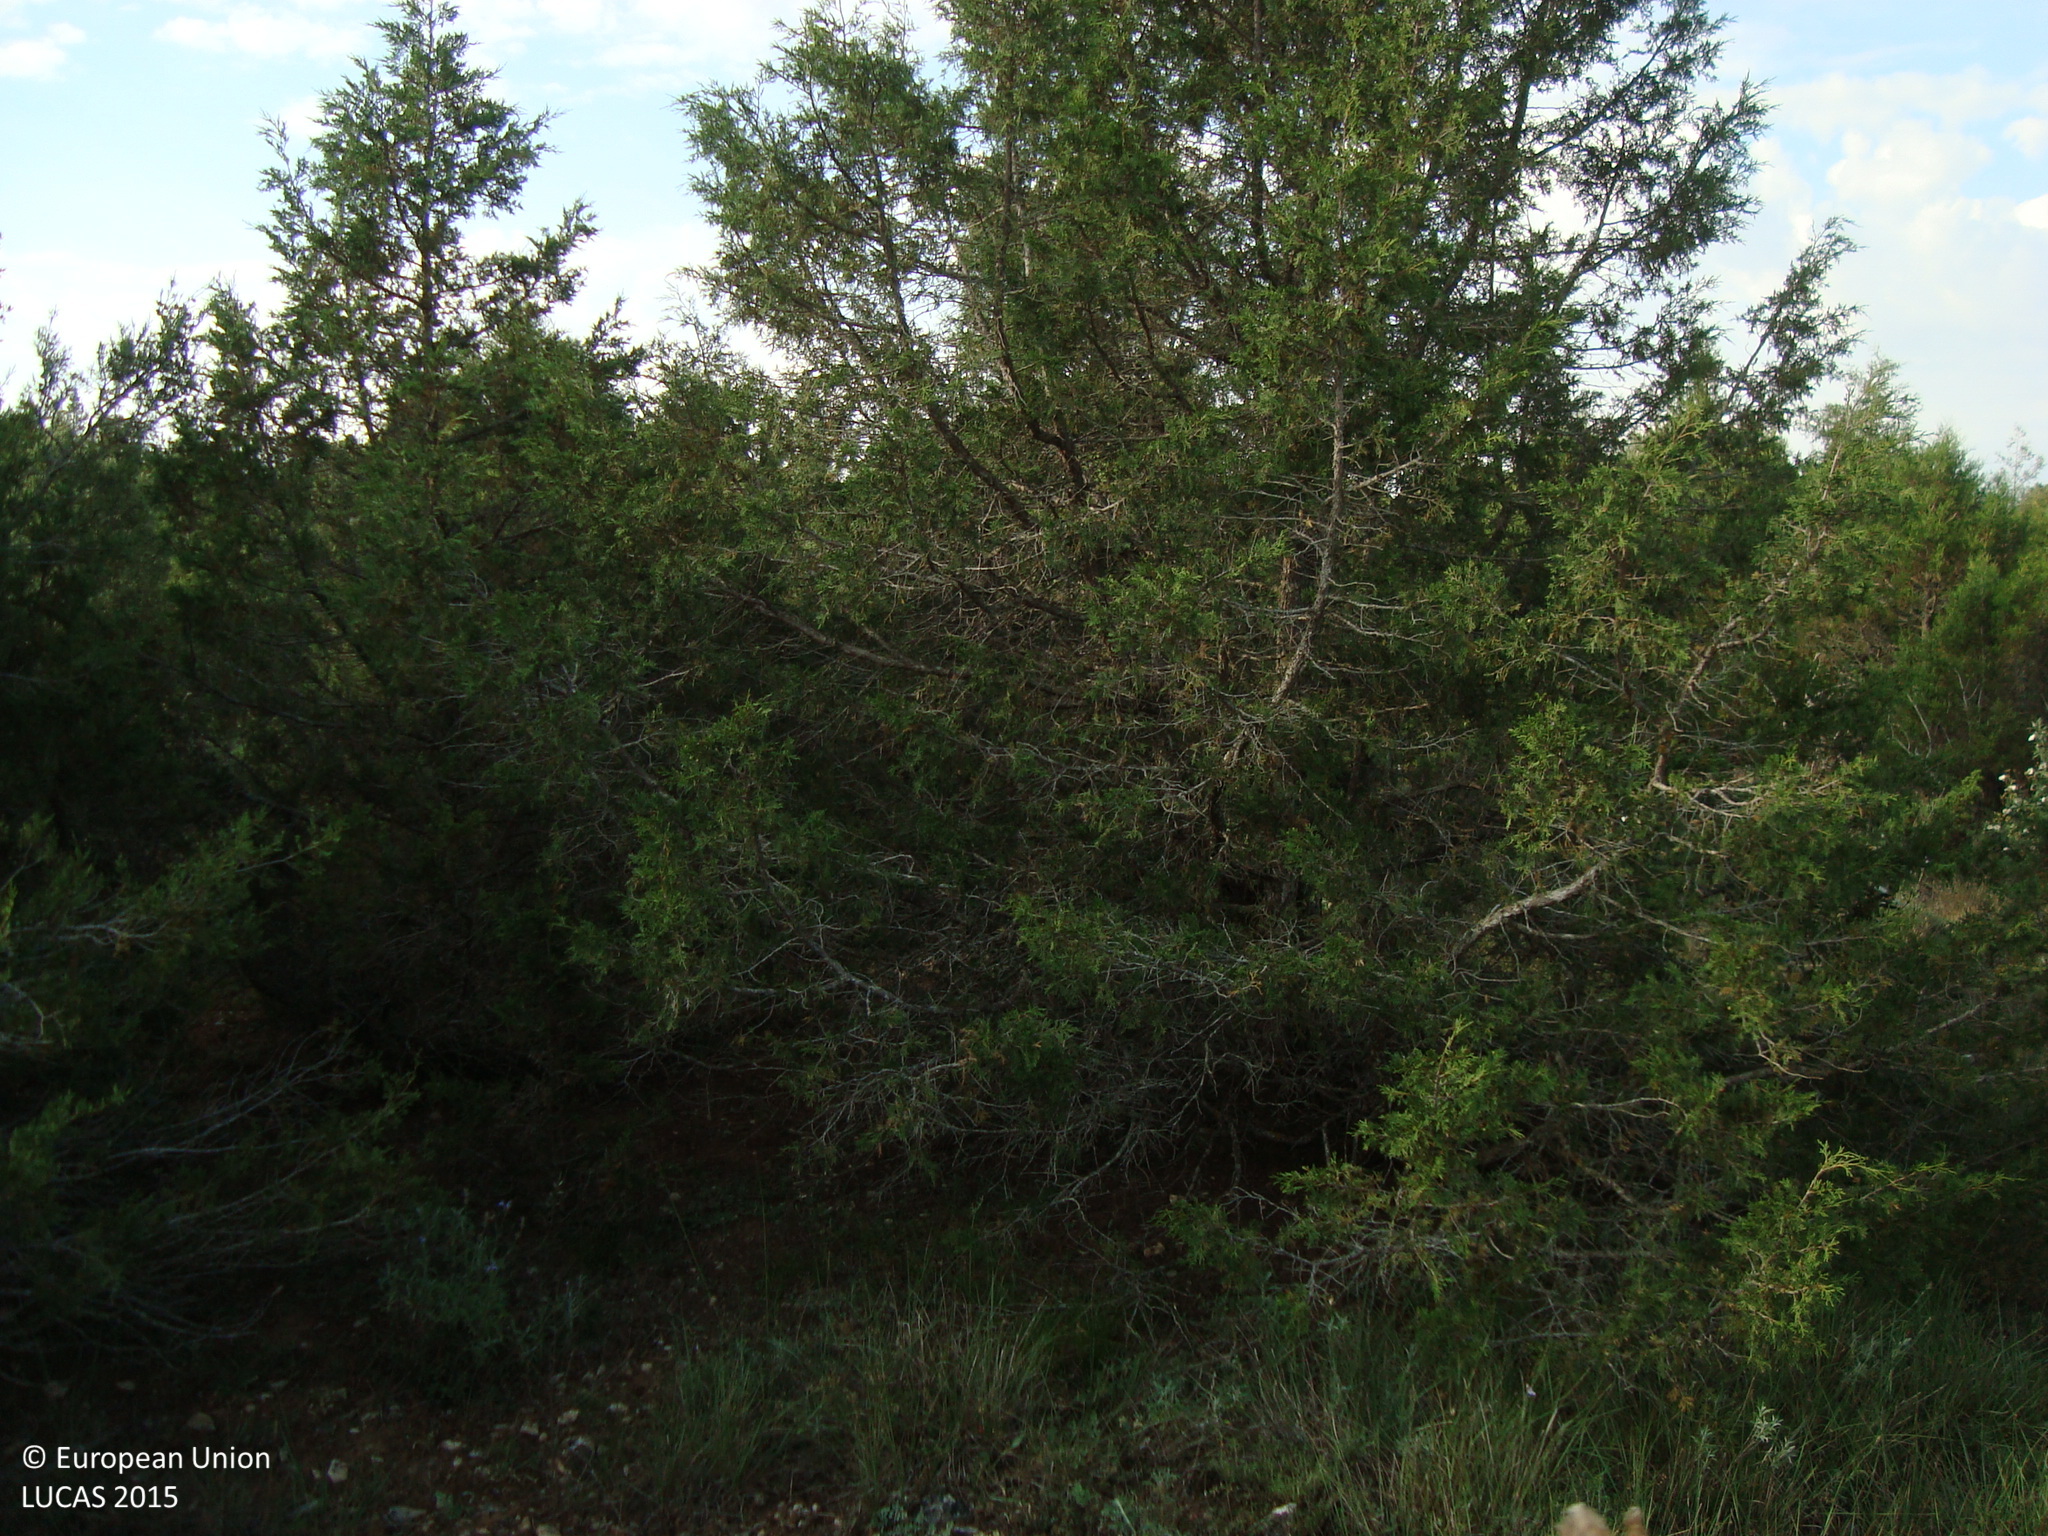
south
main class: Woodland
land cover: Other coniferous woodland
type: coniferous forest of the mediterranean region
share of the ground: 25 - 50 %
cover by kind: coniferous forest trees 40 %, shrubs 40 %, herbaceous plants 10 %, unconsolidated bare surface 10 %
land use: Forestry
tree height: > 5 m
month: June
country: ES
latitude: 41.9394
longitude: -3.8198
